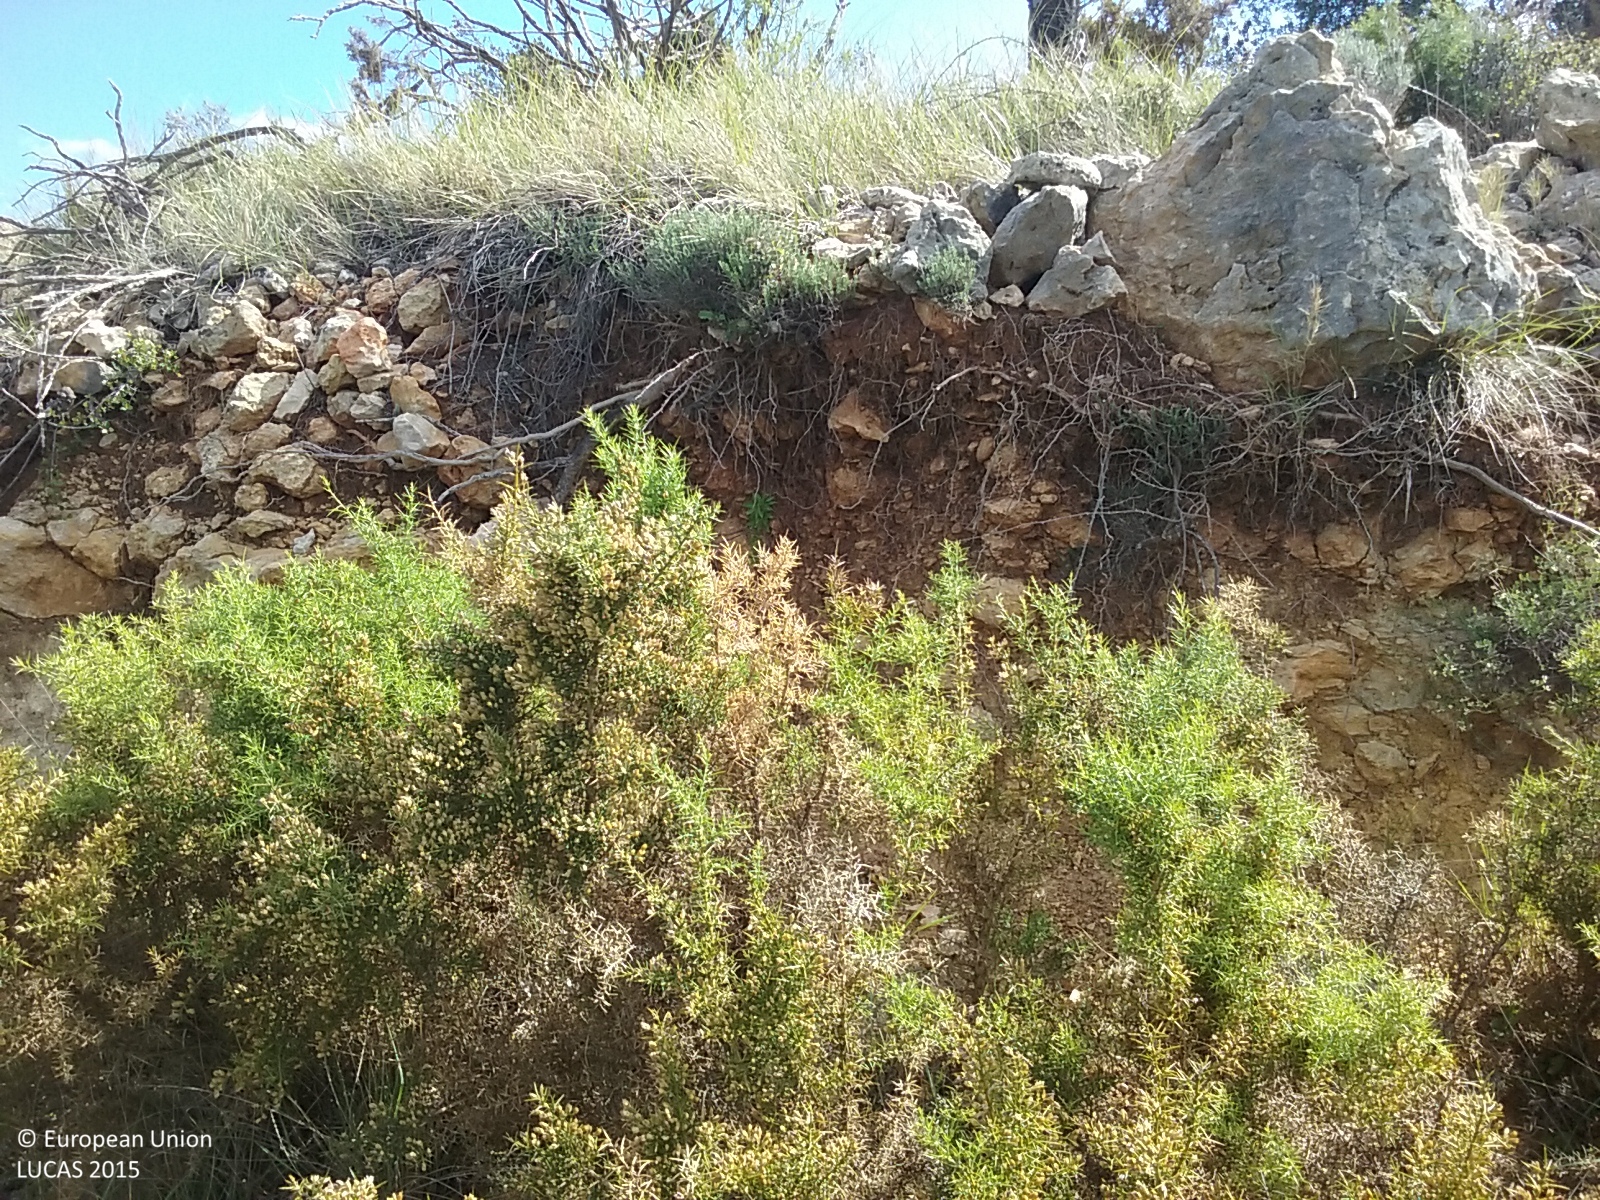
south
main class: Shrubland
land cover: Shrubland with sparse tree cover
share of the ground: > 75 %
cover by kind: shrubs 70 %, herbaceous plants 20 %, coniferous forest trees 5 %
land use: Semi-natural and natural areas not in use
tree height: < 5 m
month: May
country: ES
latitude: 40.3430
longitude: 0.0483
